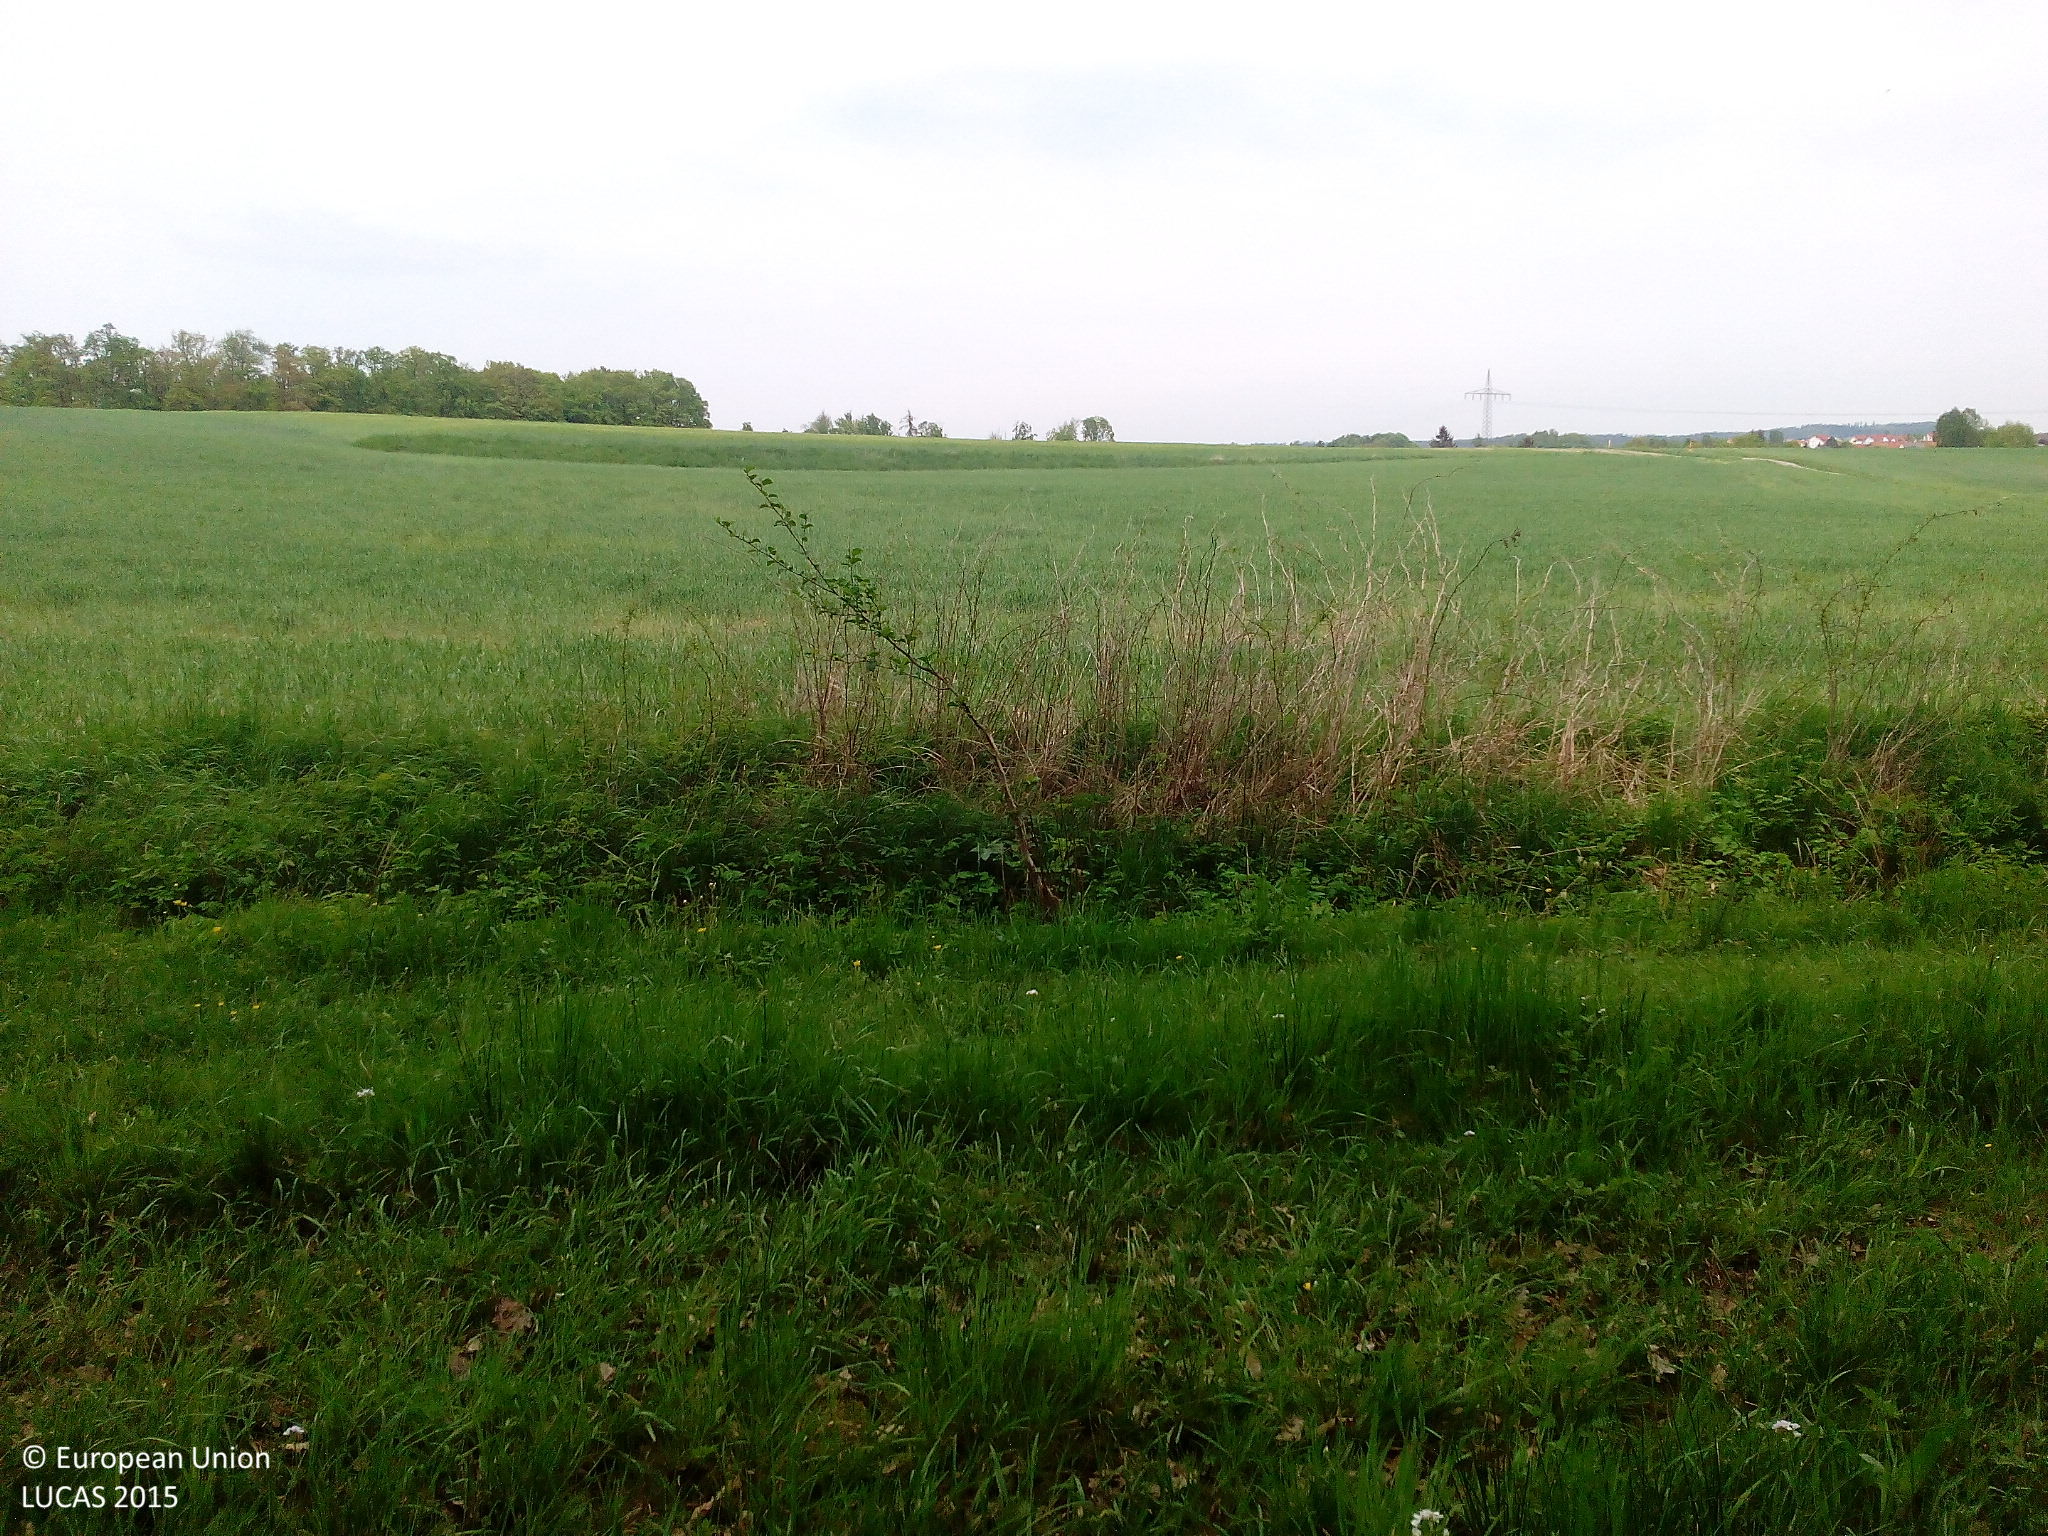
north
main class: Grassland
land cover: Grassland without tree/shrub cover
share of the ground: > 75 %
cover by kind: herbaceous plants 100 %
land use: Agriculture (excluding fallow land and kitchen gardens)
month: May
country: DE
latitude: 50.2696
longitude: 11.0239
